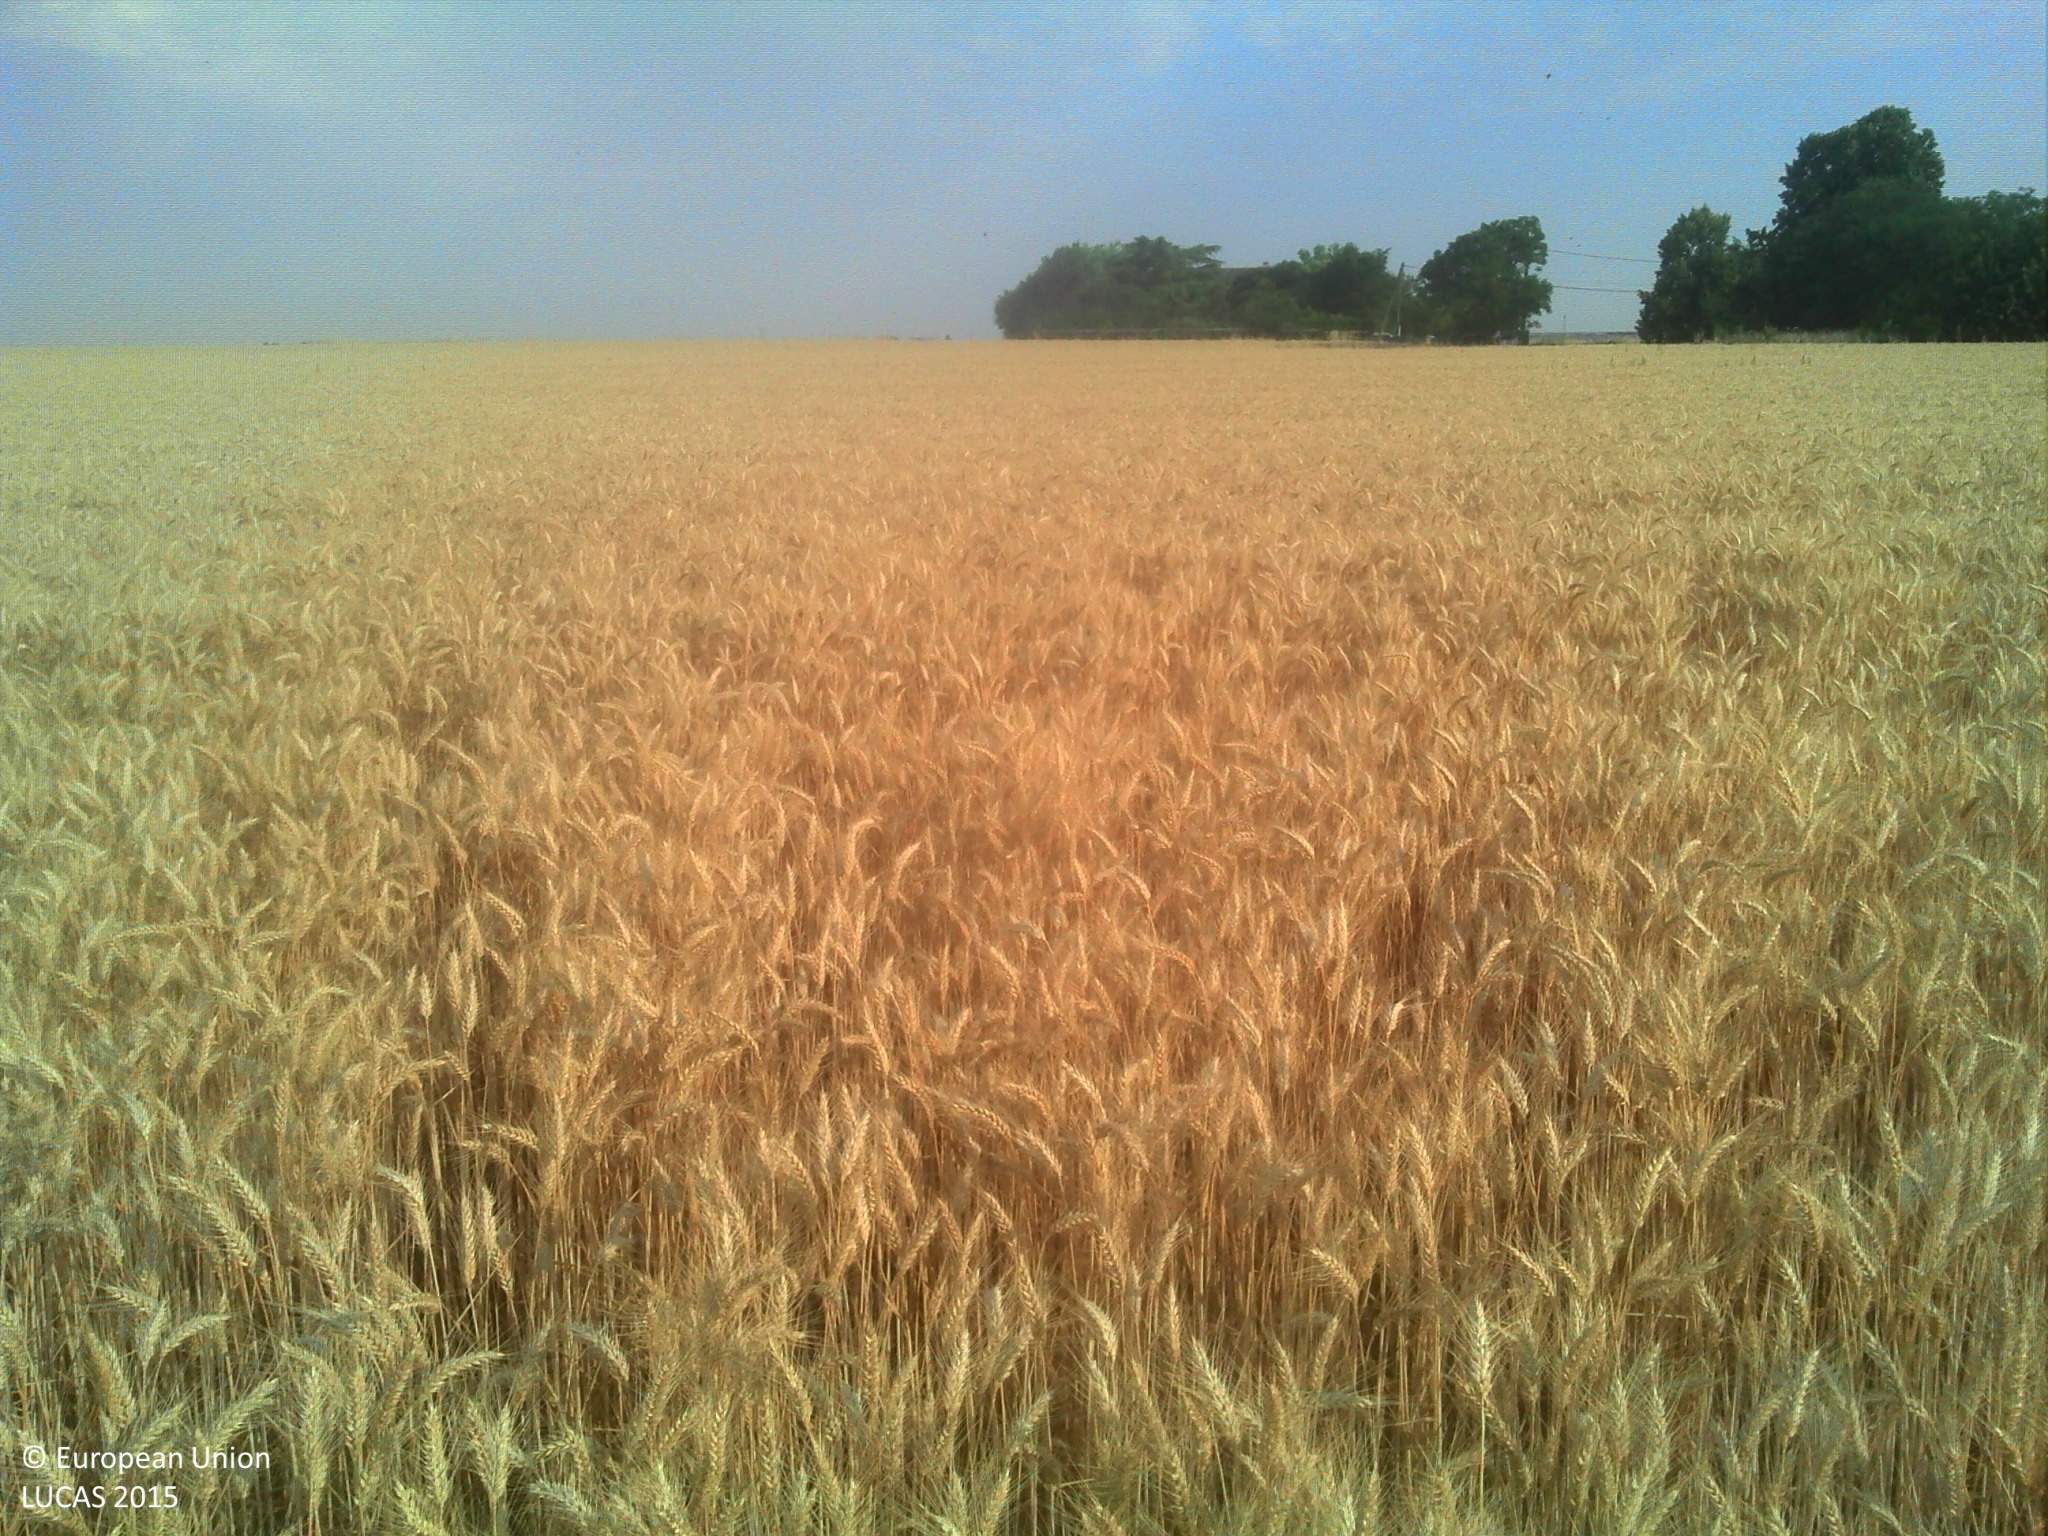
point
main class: Cropland
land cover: Durum wheat
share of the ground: > 75 %
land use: Agriculture (excluding fallow land and kitchen gardens)
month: July
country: FR
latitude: 47.6316
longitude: 1.3743
